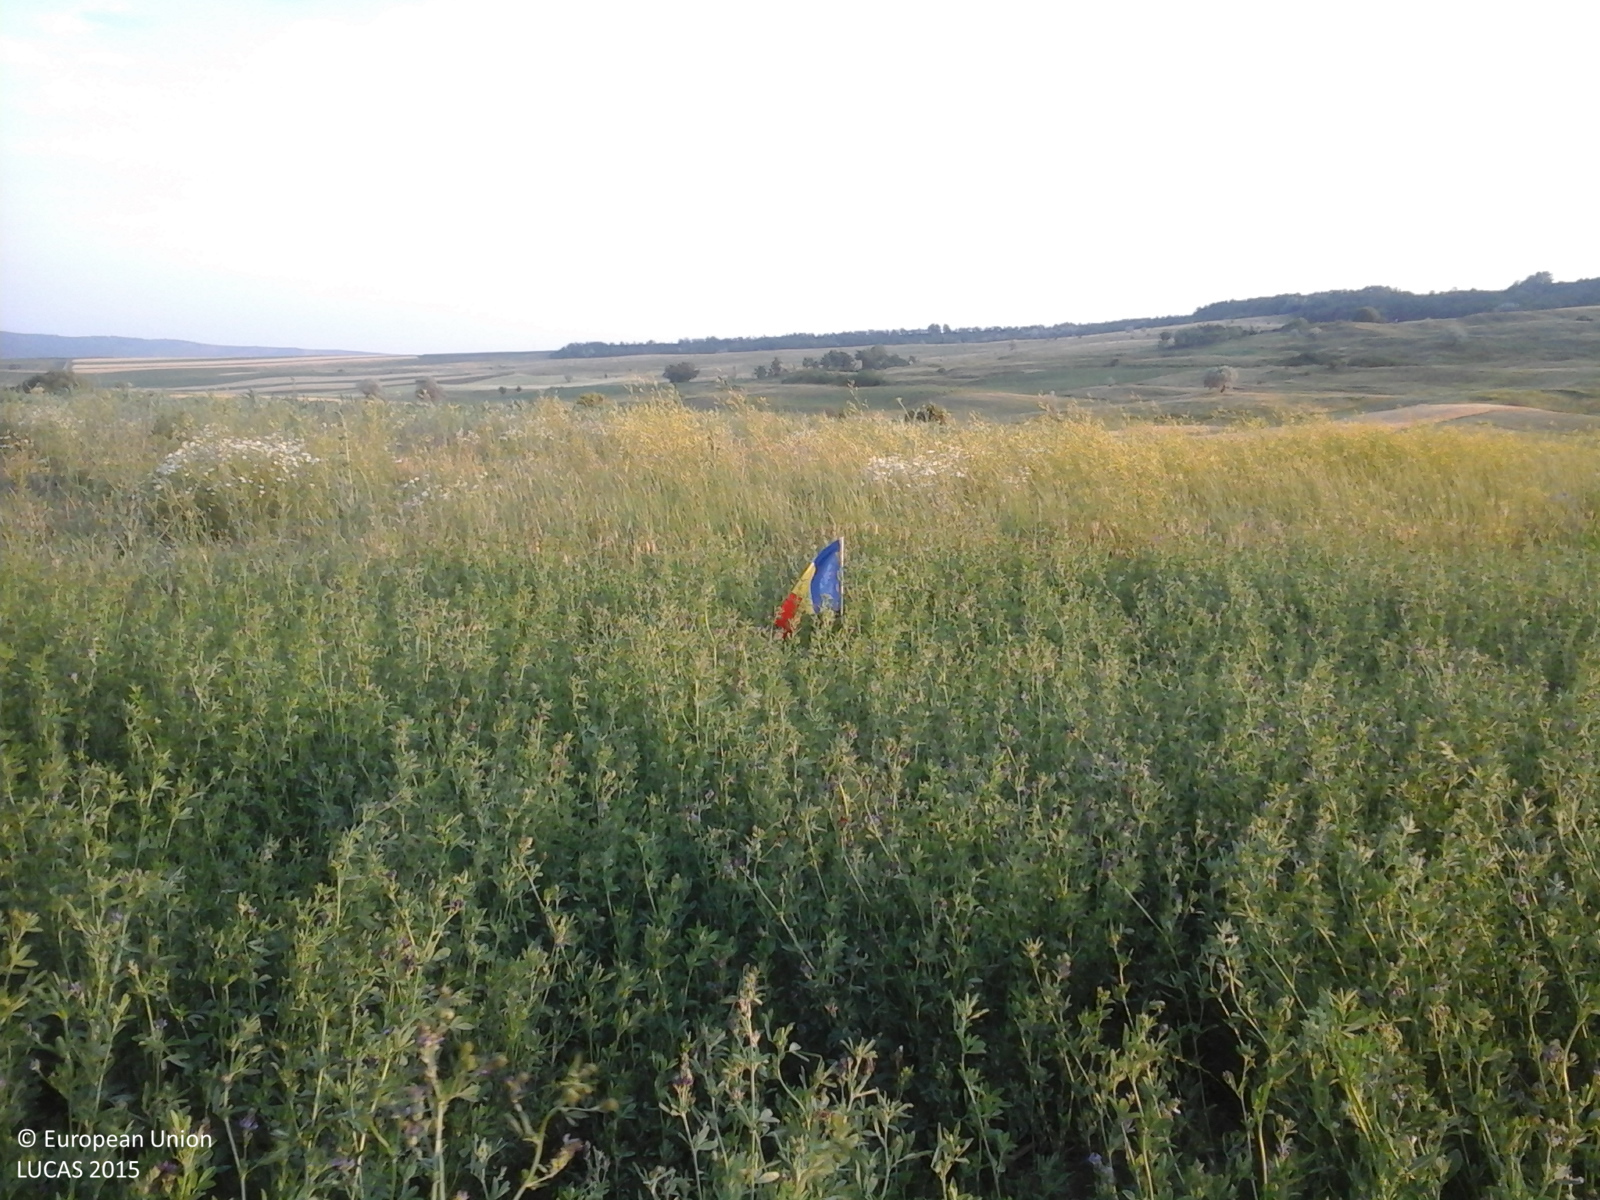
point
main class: Cropland
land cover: Lucerne
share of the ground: > 75 %
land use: Agriculture (excluding fallow land and kitchen gardens)
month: June
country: RO
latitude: 46.8644
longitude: 27.3865
